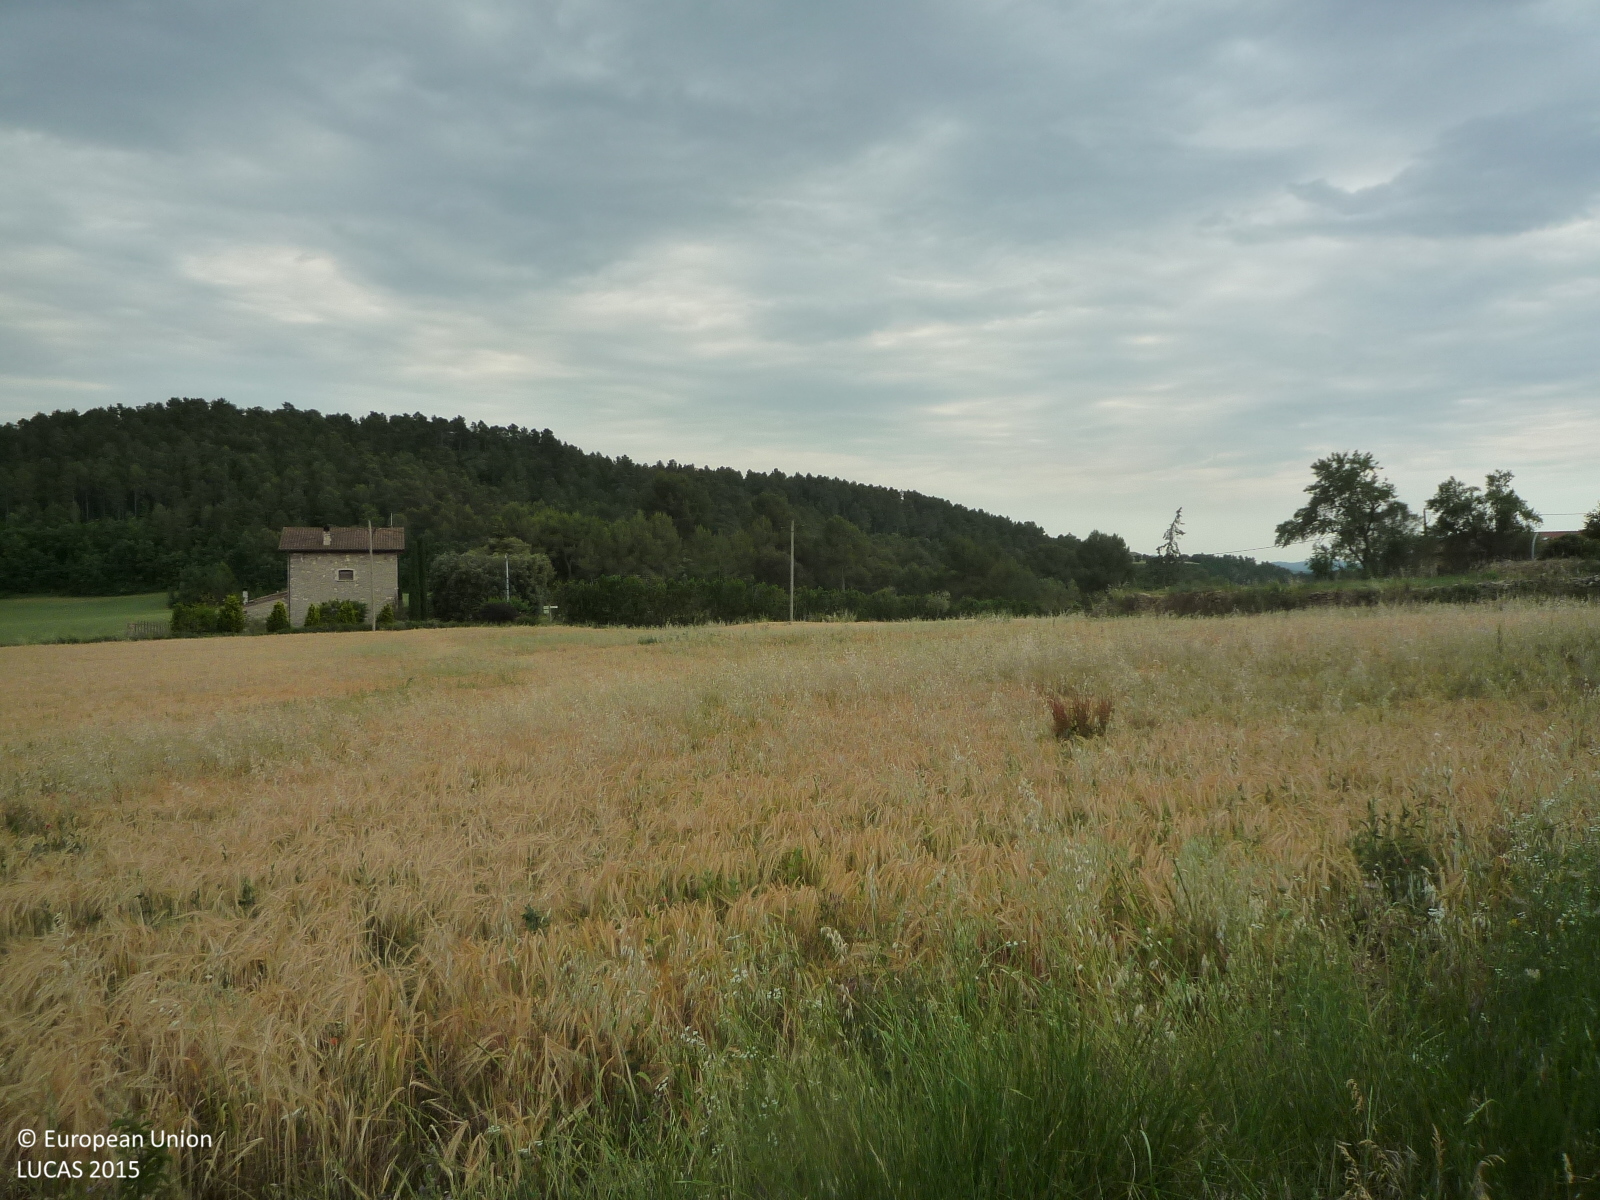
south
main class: Shrubland
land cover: Shrubland without tree cover
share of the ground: > 75 %
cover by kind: shrubs 70 %, herbaceous plants 30 %
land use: Semi-natural and natural areas not in use
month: June
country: ES
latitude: 41.8477
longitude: 2.0055
